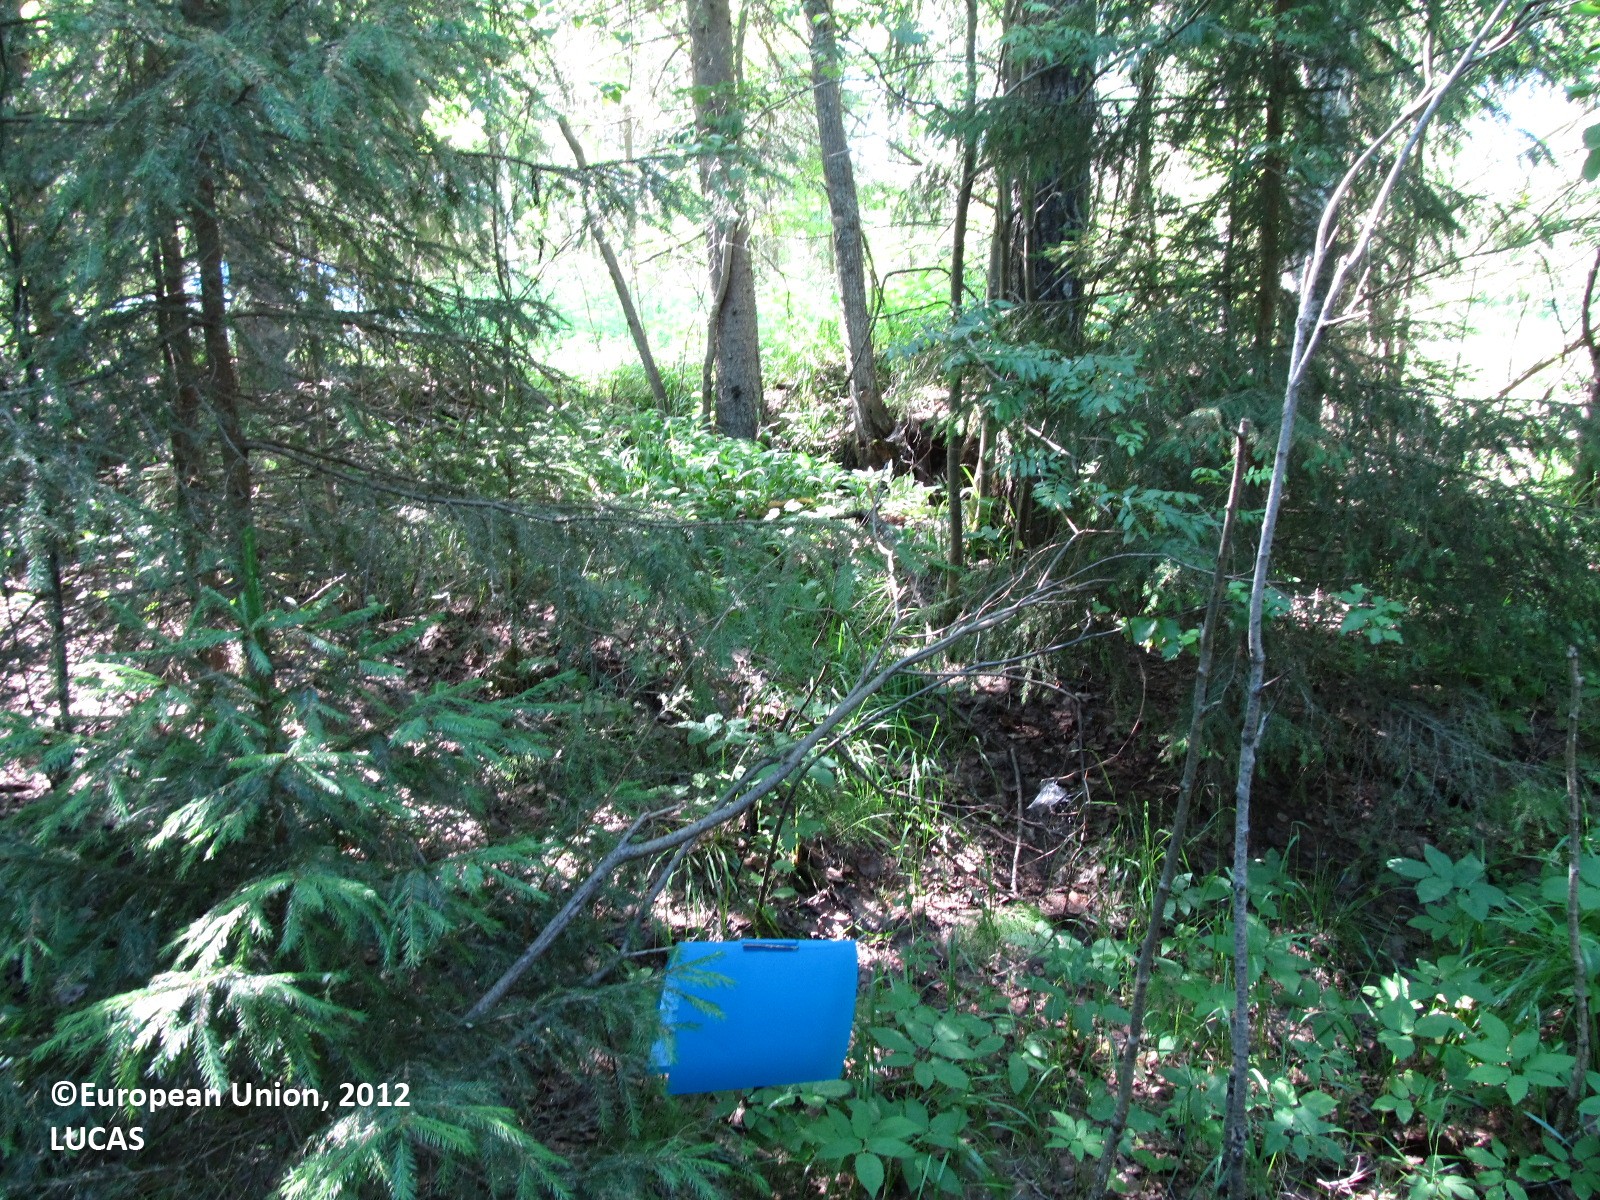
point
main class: Woodland
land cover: Spruce dominated mixed woodland
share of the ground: 50 - 75 %
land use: Forestry
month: July
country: FI
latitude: 62.2484
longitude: 29.2321
